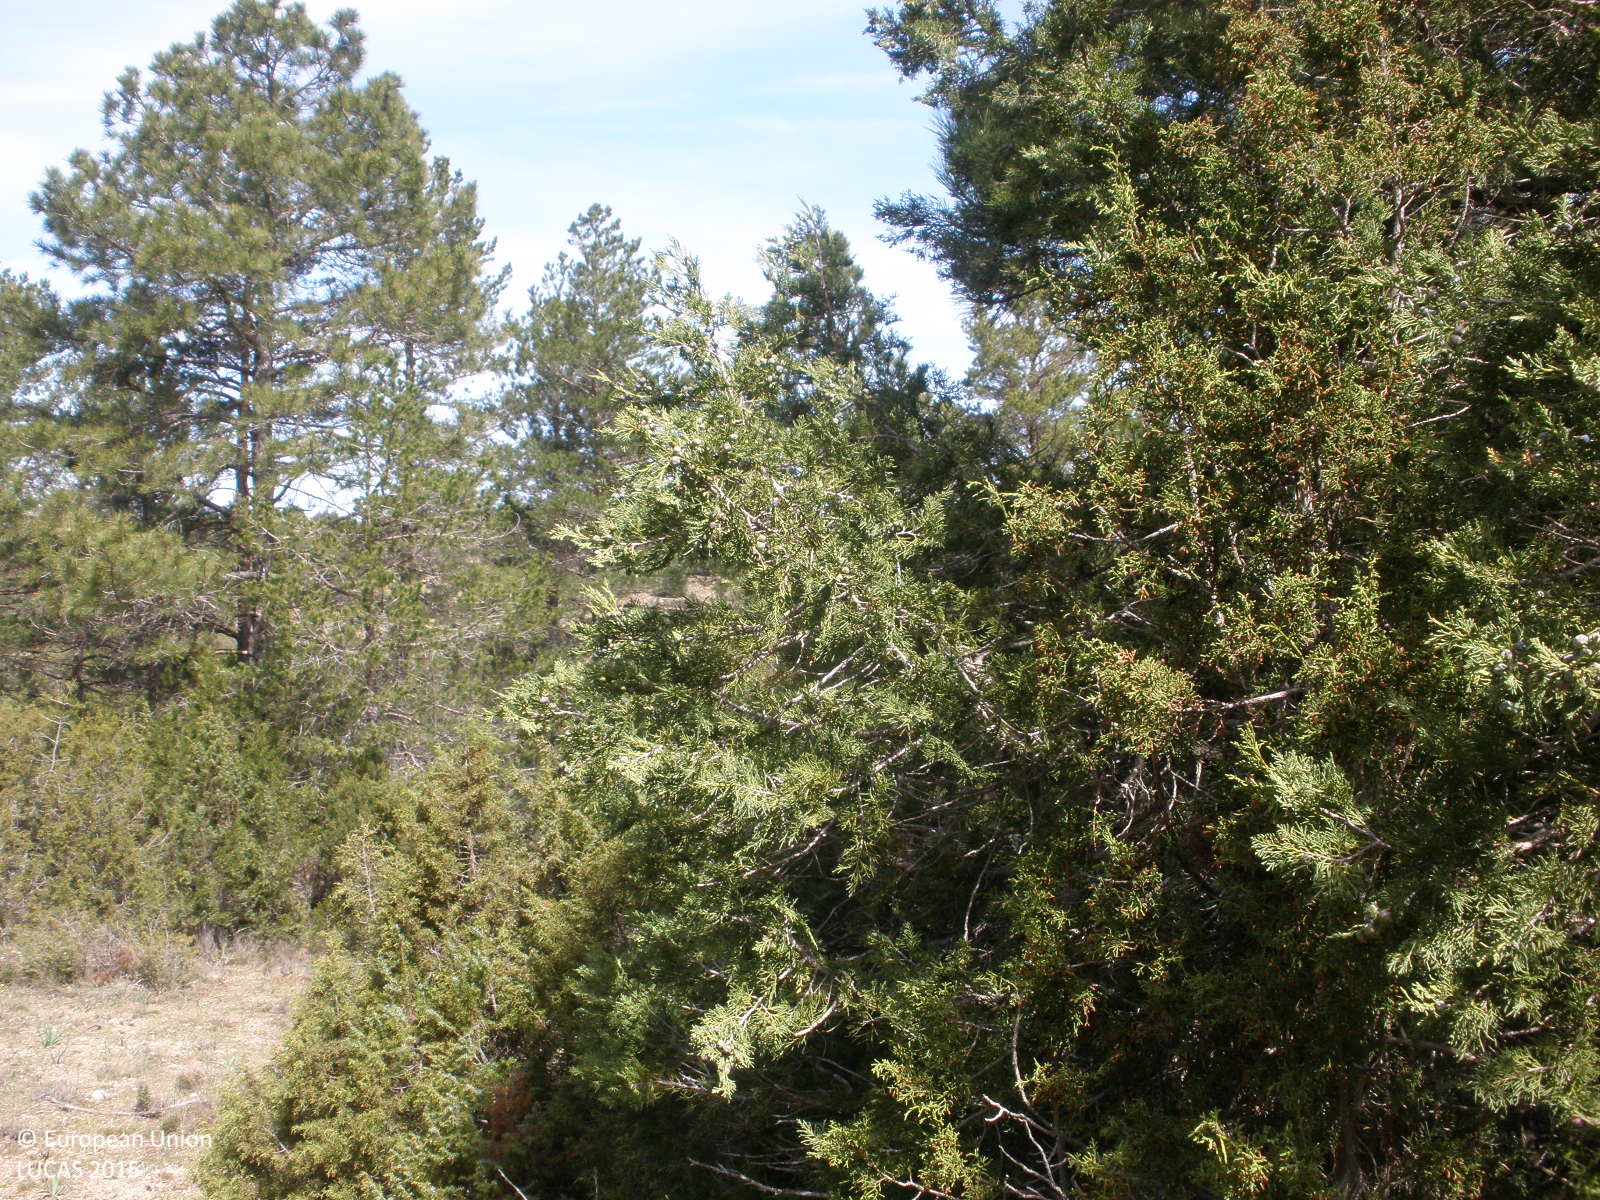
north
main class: Woodland
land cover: Pine dominated coniferous woodland
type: coniferous forest of the mediterranean region
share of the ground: > 75 %
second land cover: Grassland without tree/shrub cover
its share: > 75 %
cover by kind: coniferous forest trees 40 %, shrubs 30 %, herbaceous plants 20 %, consolidated bare surface 10 %
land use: Forestry
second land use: Agriculture (excluding fallow land and kitchen gardens)
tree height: > 5 m
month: April
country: ES
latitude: 40.2156
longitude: -0.9714
